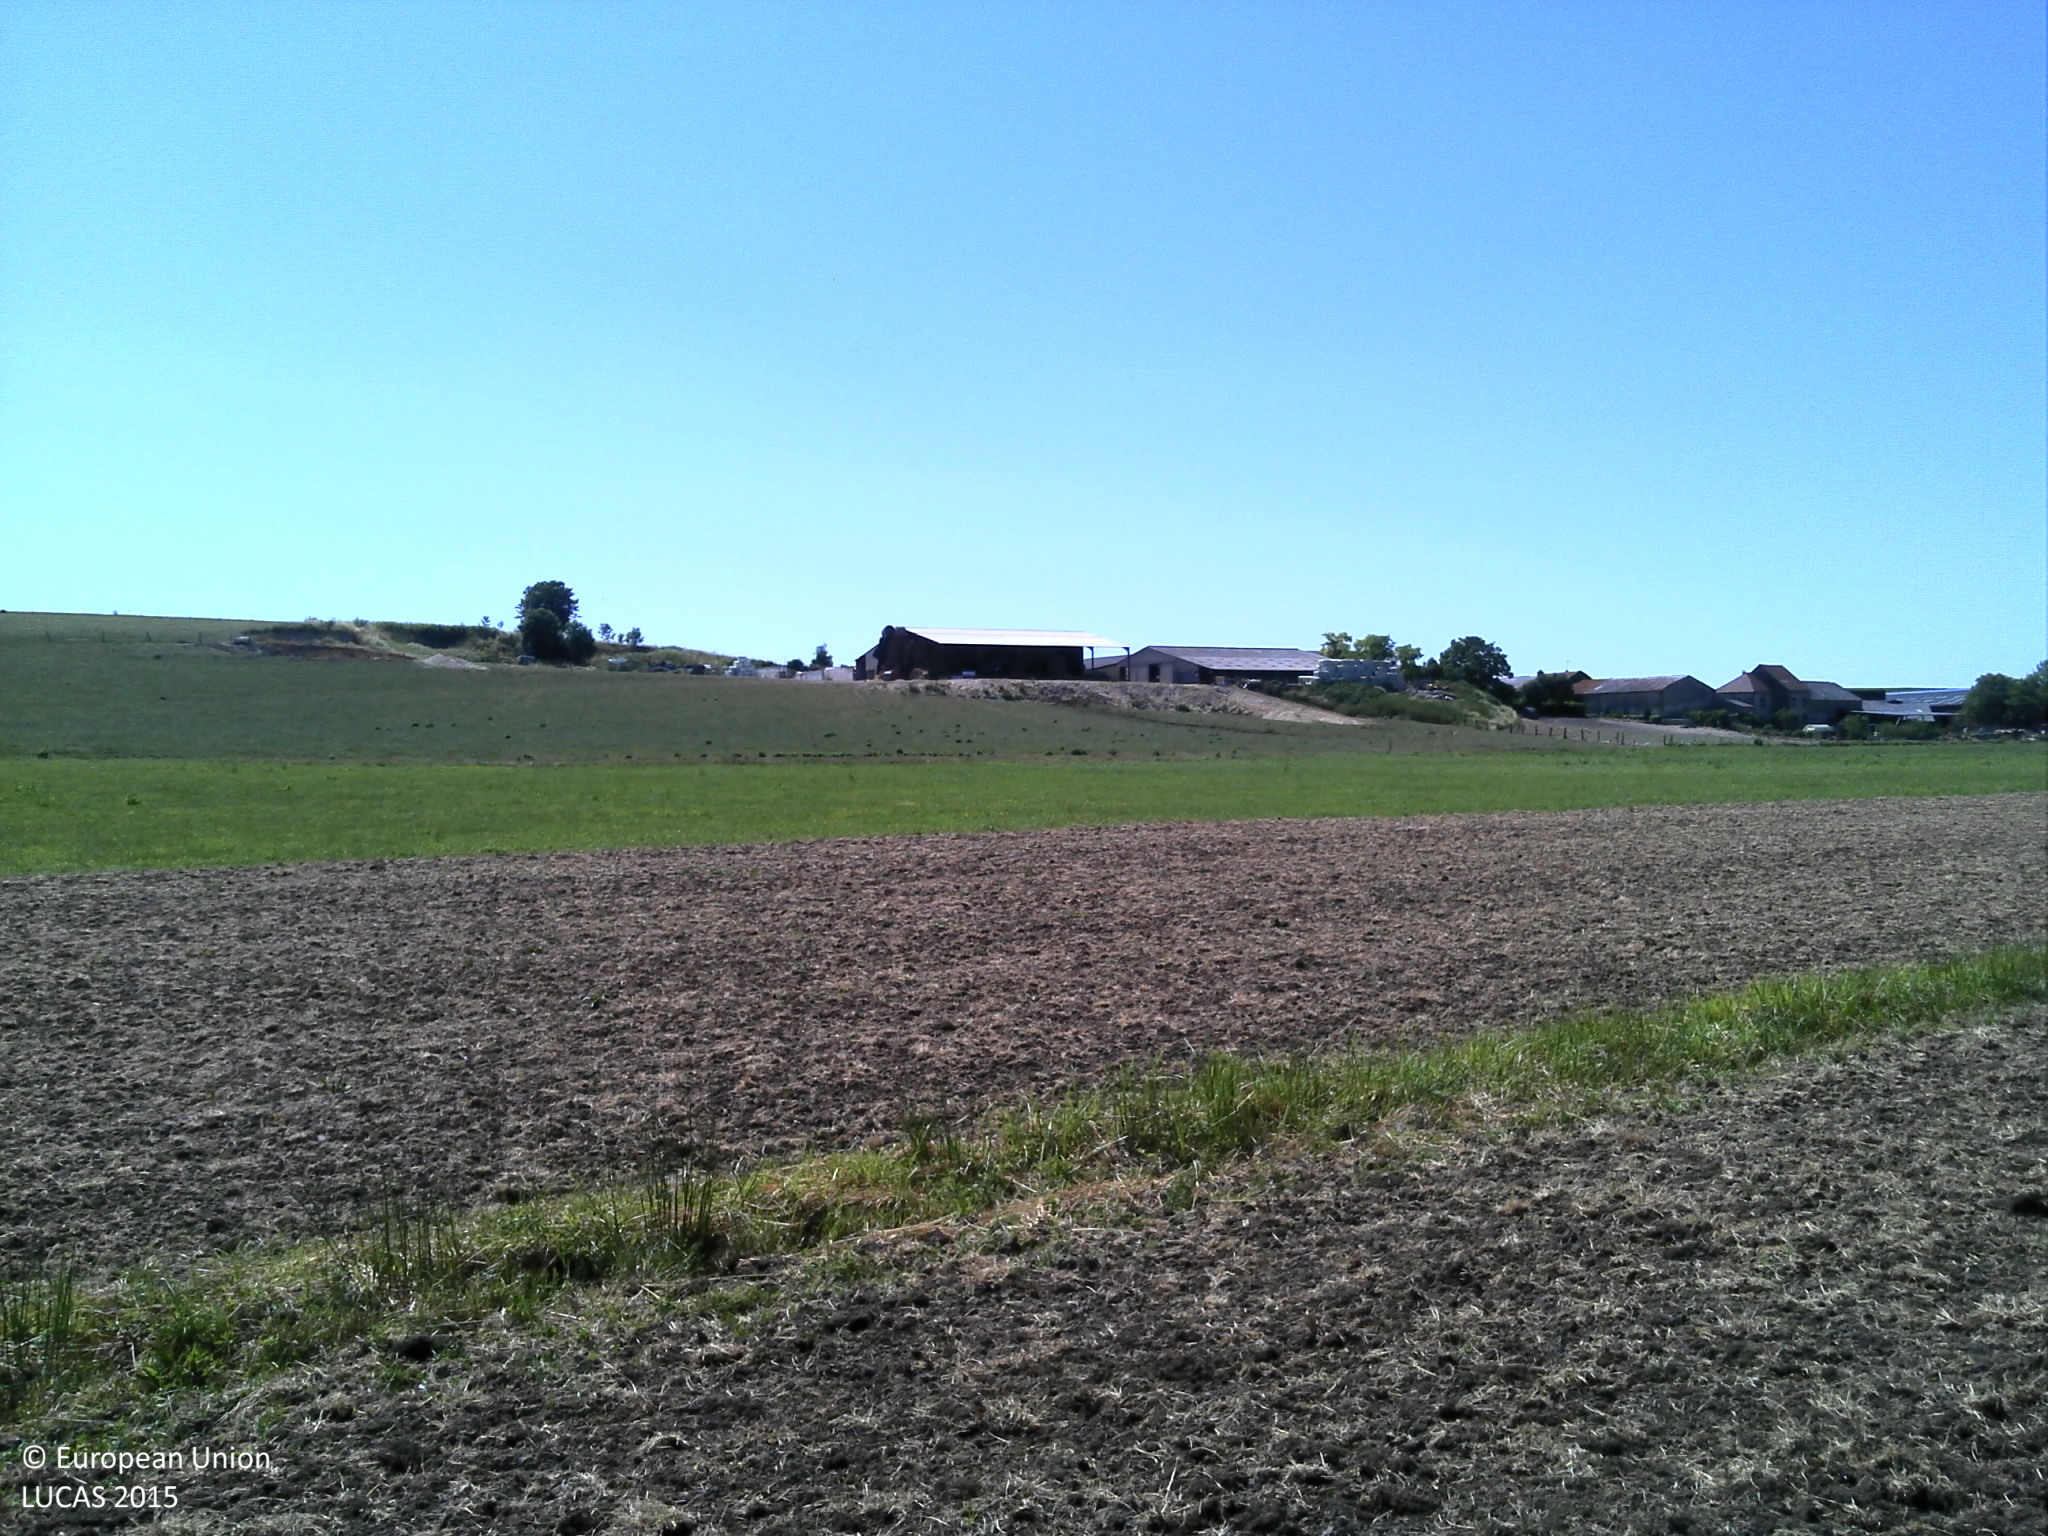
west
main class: Grassland
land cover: Grassland without tree/shrub cover
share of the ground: > 75 %
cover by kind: herbaceous plants 100 %
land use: Agriculture (excluding fallow land and kitchen gardens)
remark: Tilled/Sowed
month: July
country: FR
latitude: 49.4899
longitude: 4.8202
